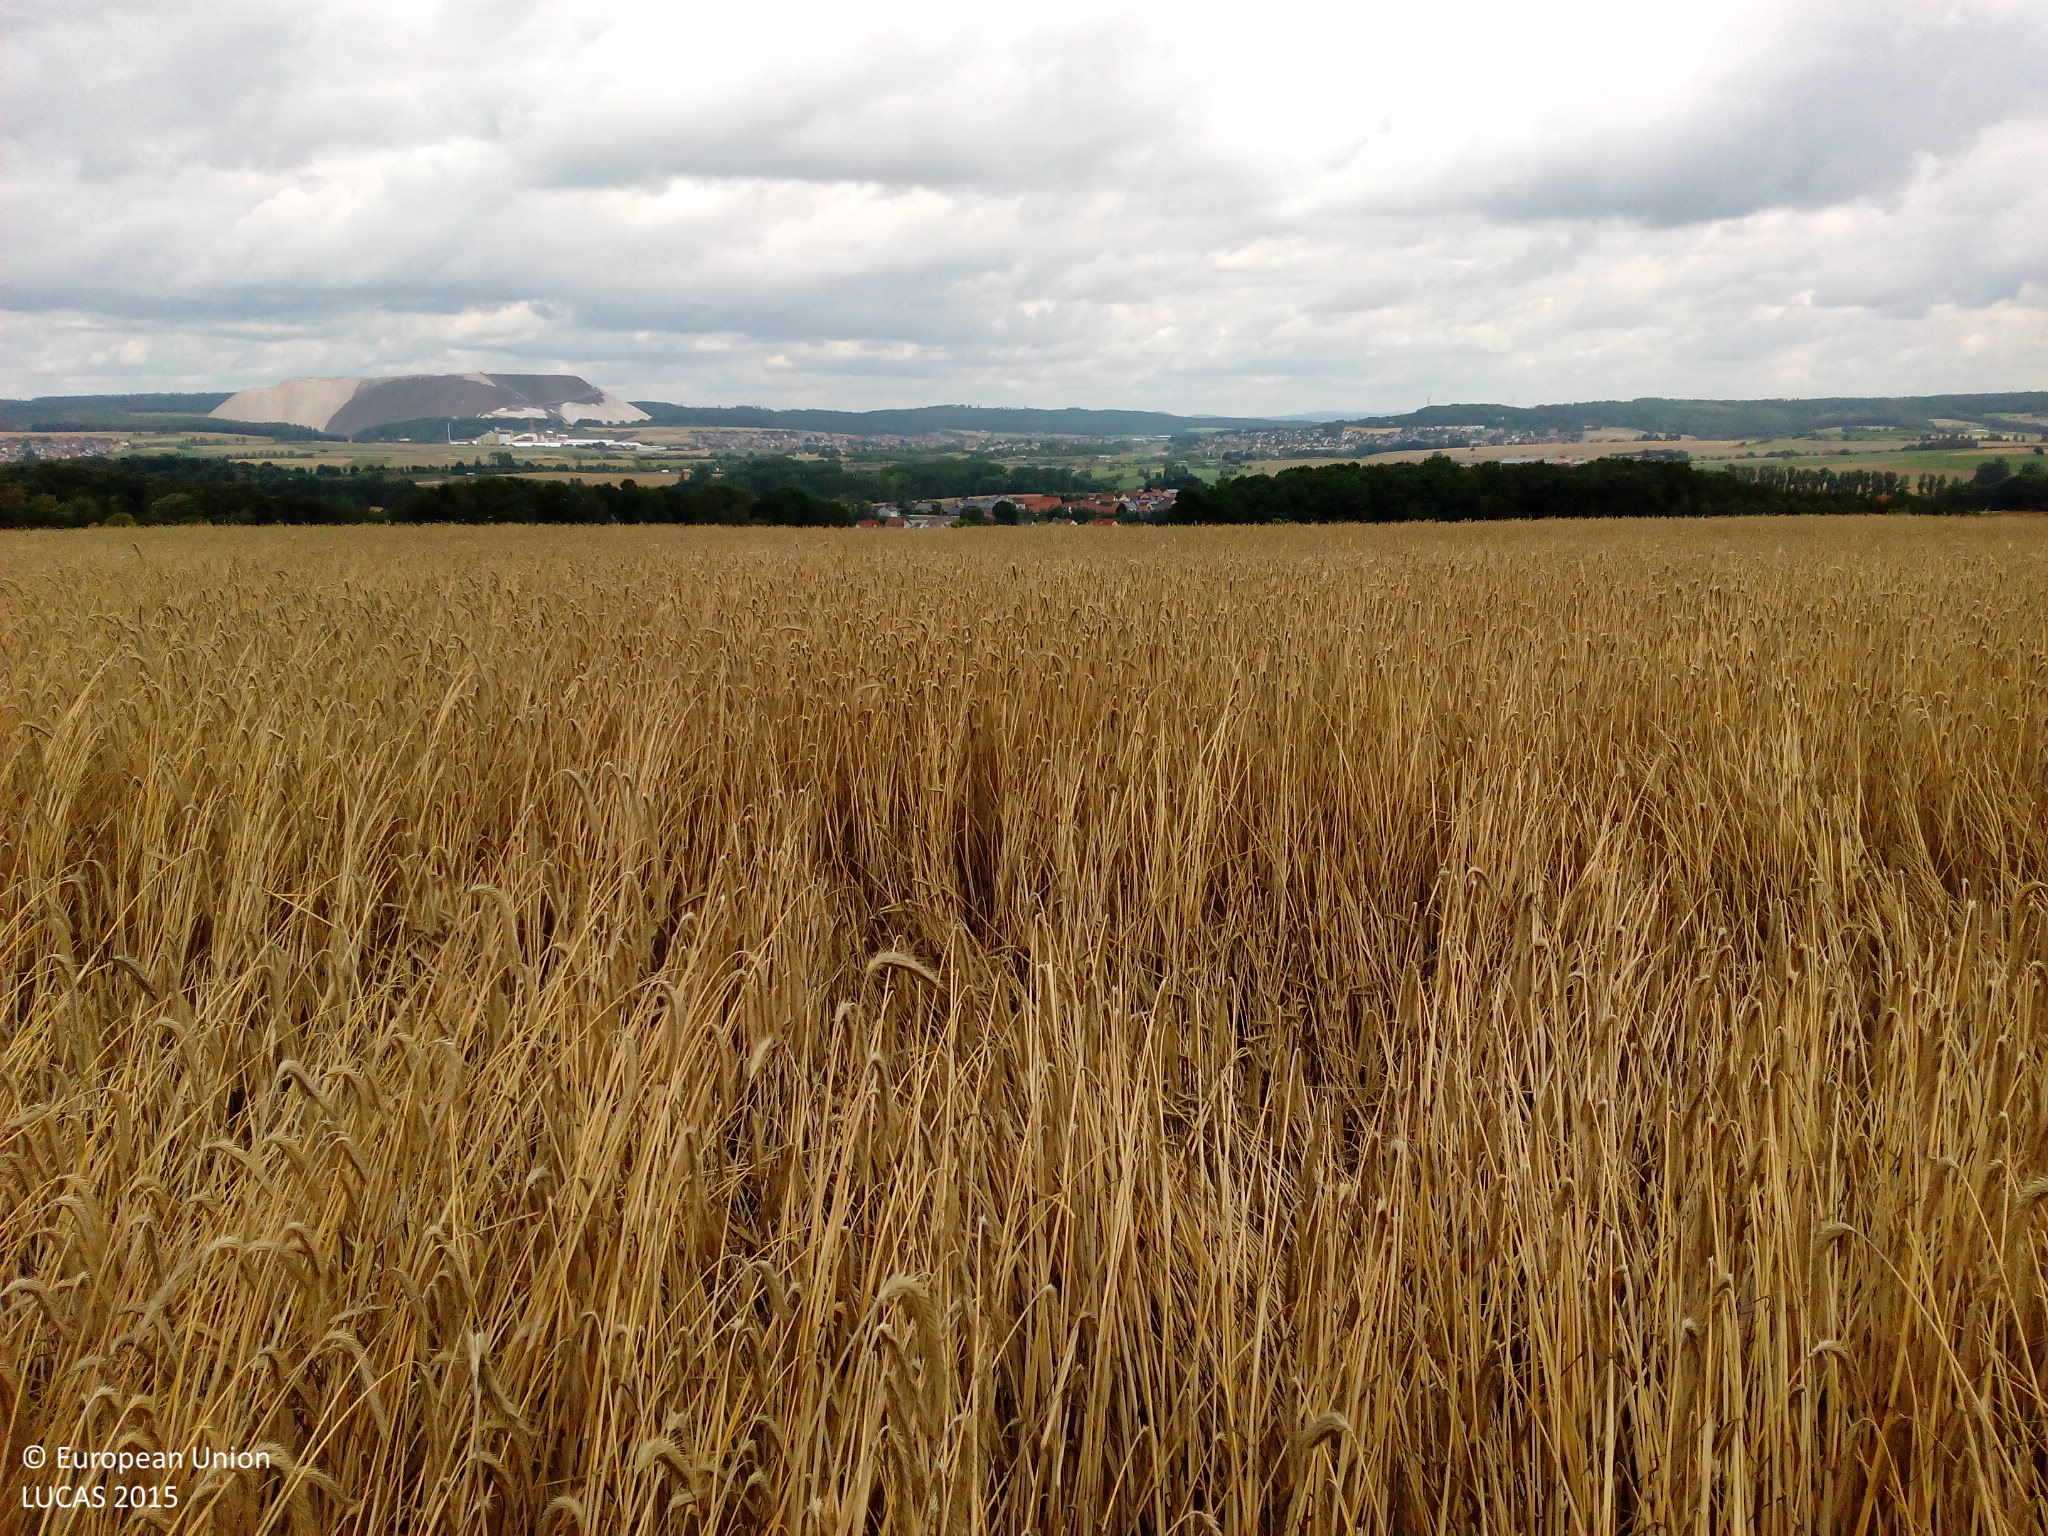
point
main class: Cropland
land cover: Triticale
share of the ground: > 75 %
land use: Agriculture (excluding fallow land and kitchen gardens)
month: July
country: DE
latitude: 50.4173
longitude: 9.5920
